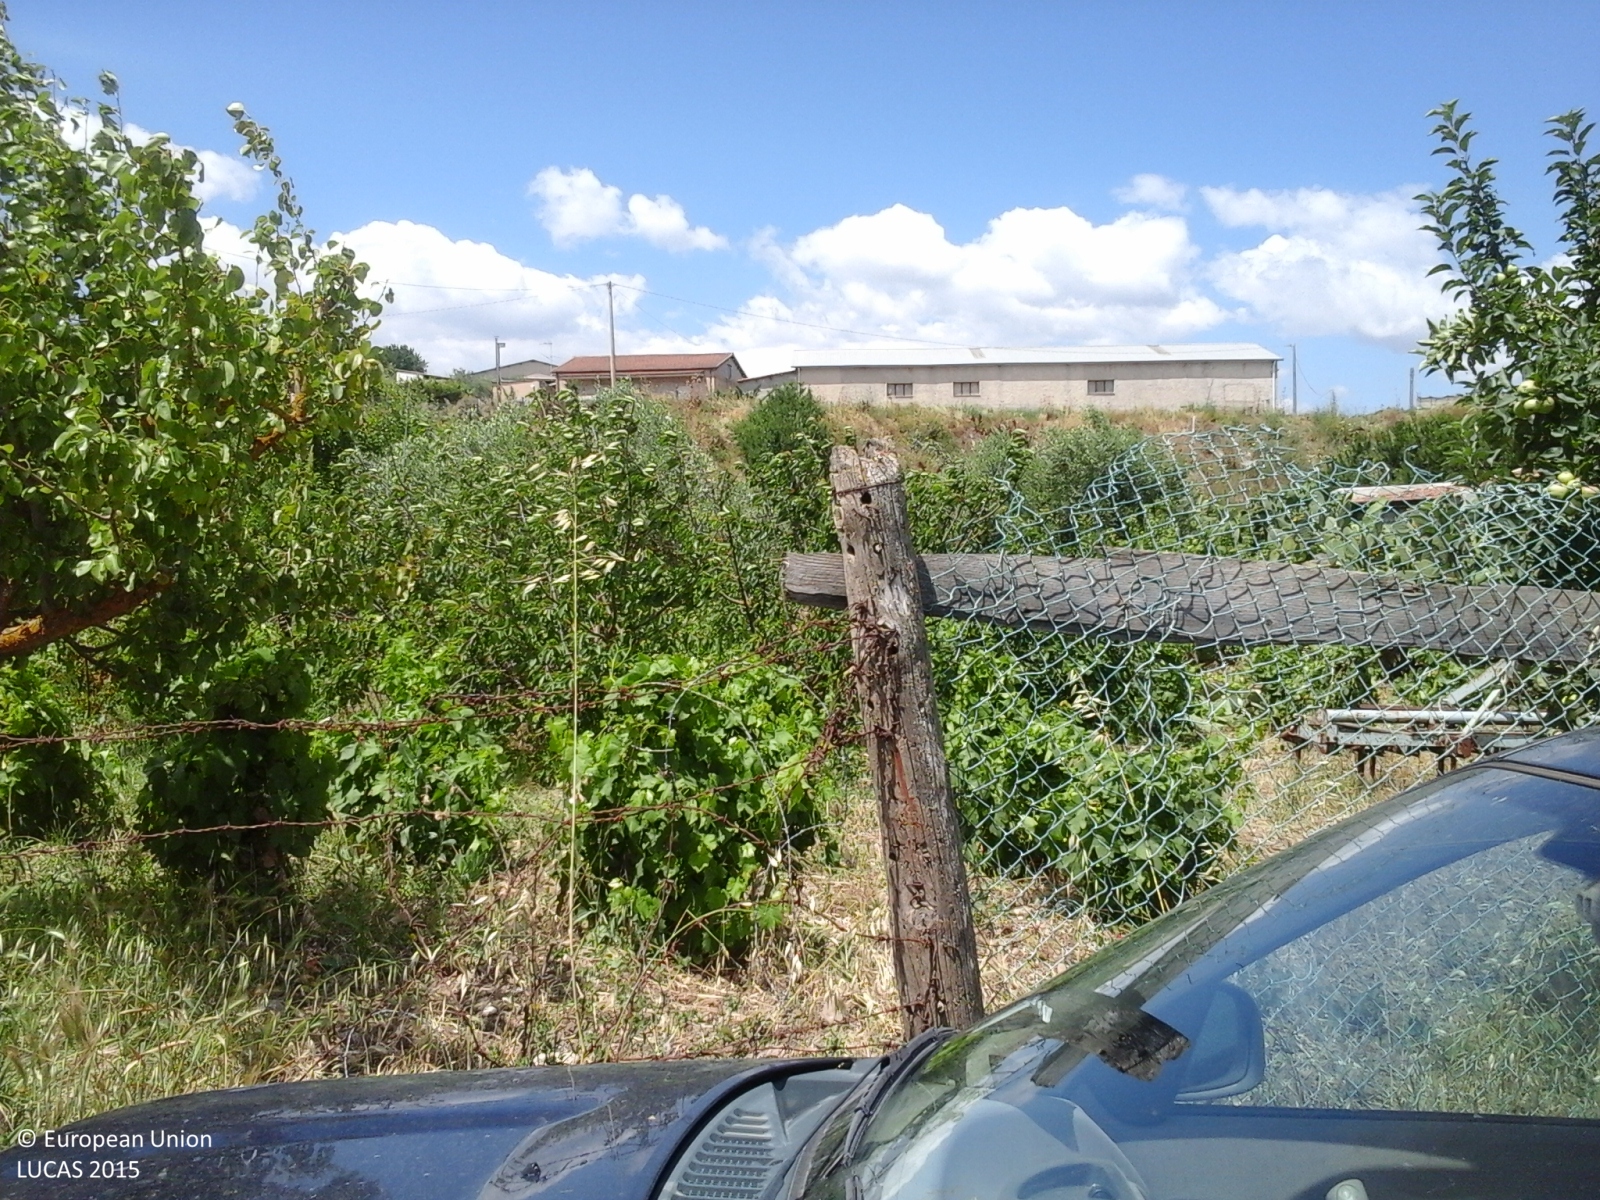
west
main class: Grassland
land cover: Grassland without tree/shrub cover
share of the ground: > 75 %
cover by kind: herbaceous plants 100 %
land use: Agriculture (excluding fallow land and kitchen gardens)
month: June
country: IT
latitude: 37.7514
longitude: 13.6168
